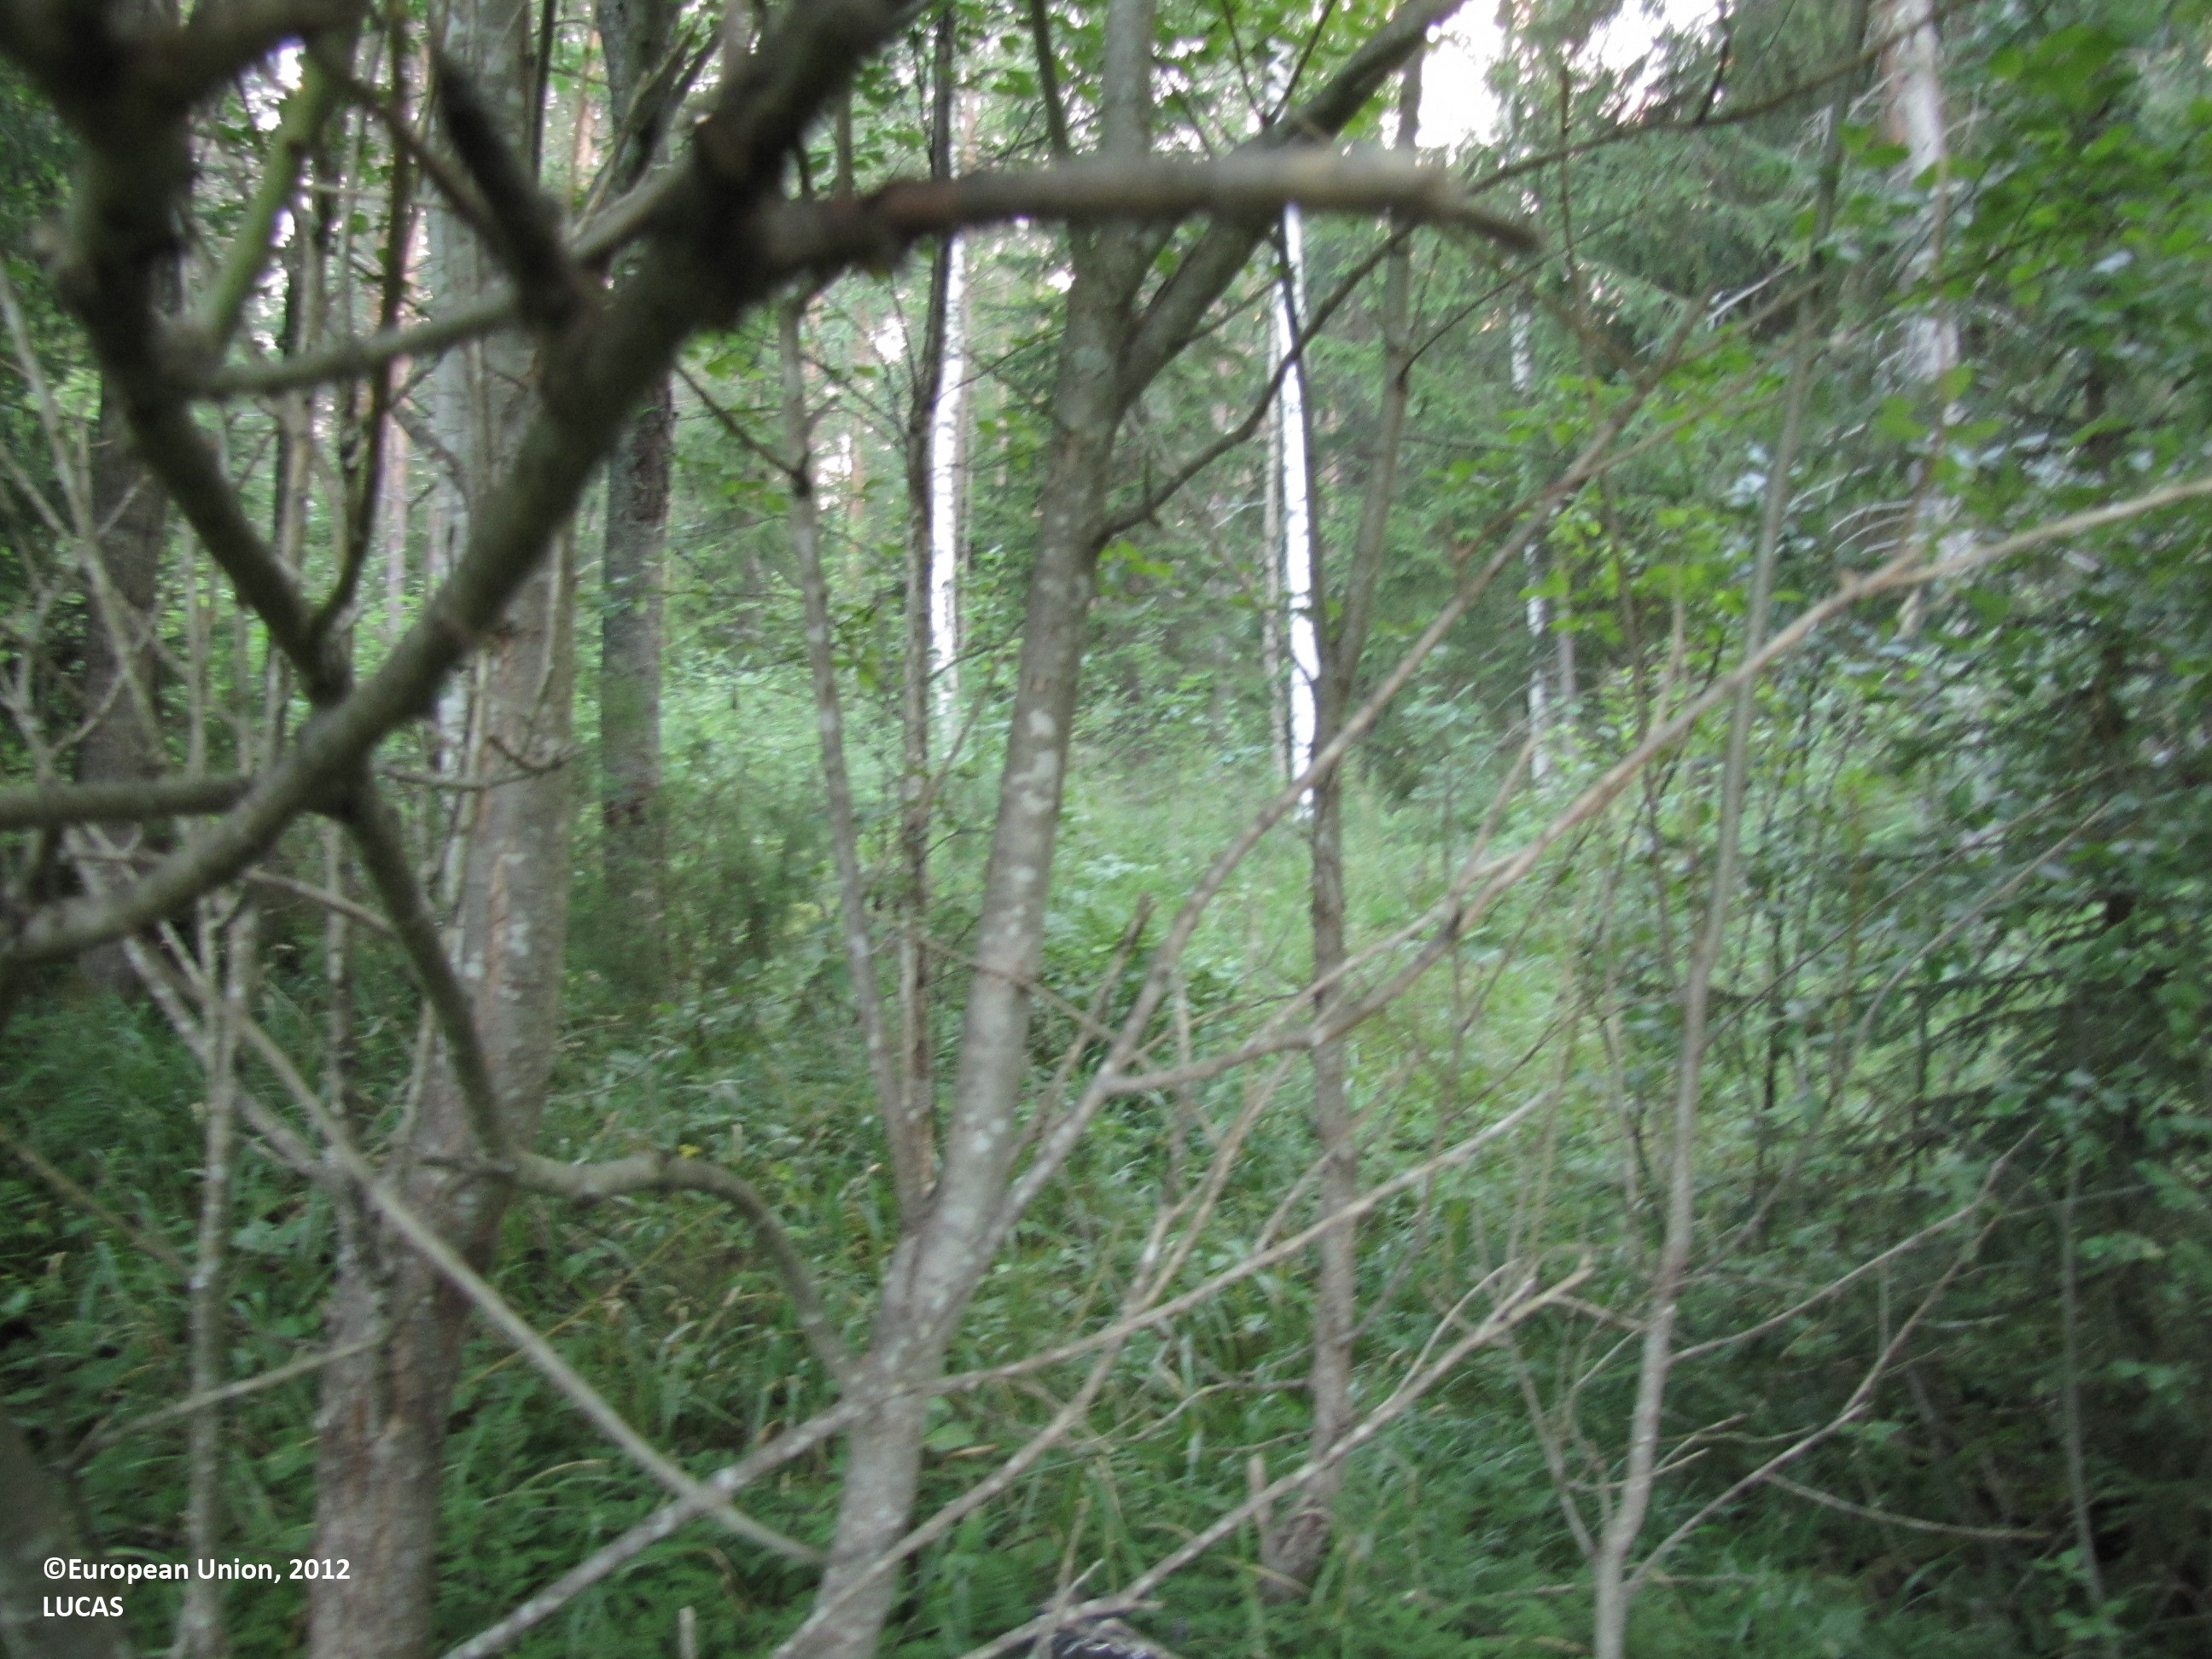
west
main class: Woodland
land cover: Other mixed woodland
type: boreal forest
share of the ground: 25 - 50 %
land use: Forestry
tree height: > 5 m
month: July
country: FI
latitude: 61.9661
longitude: 23.8717
